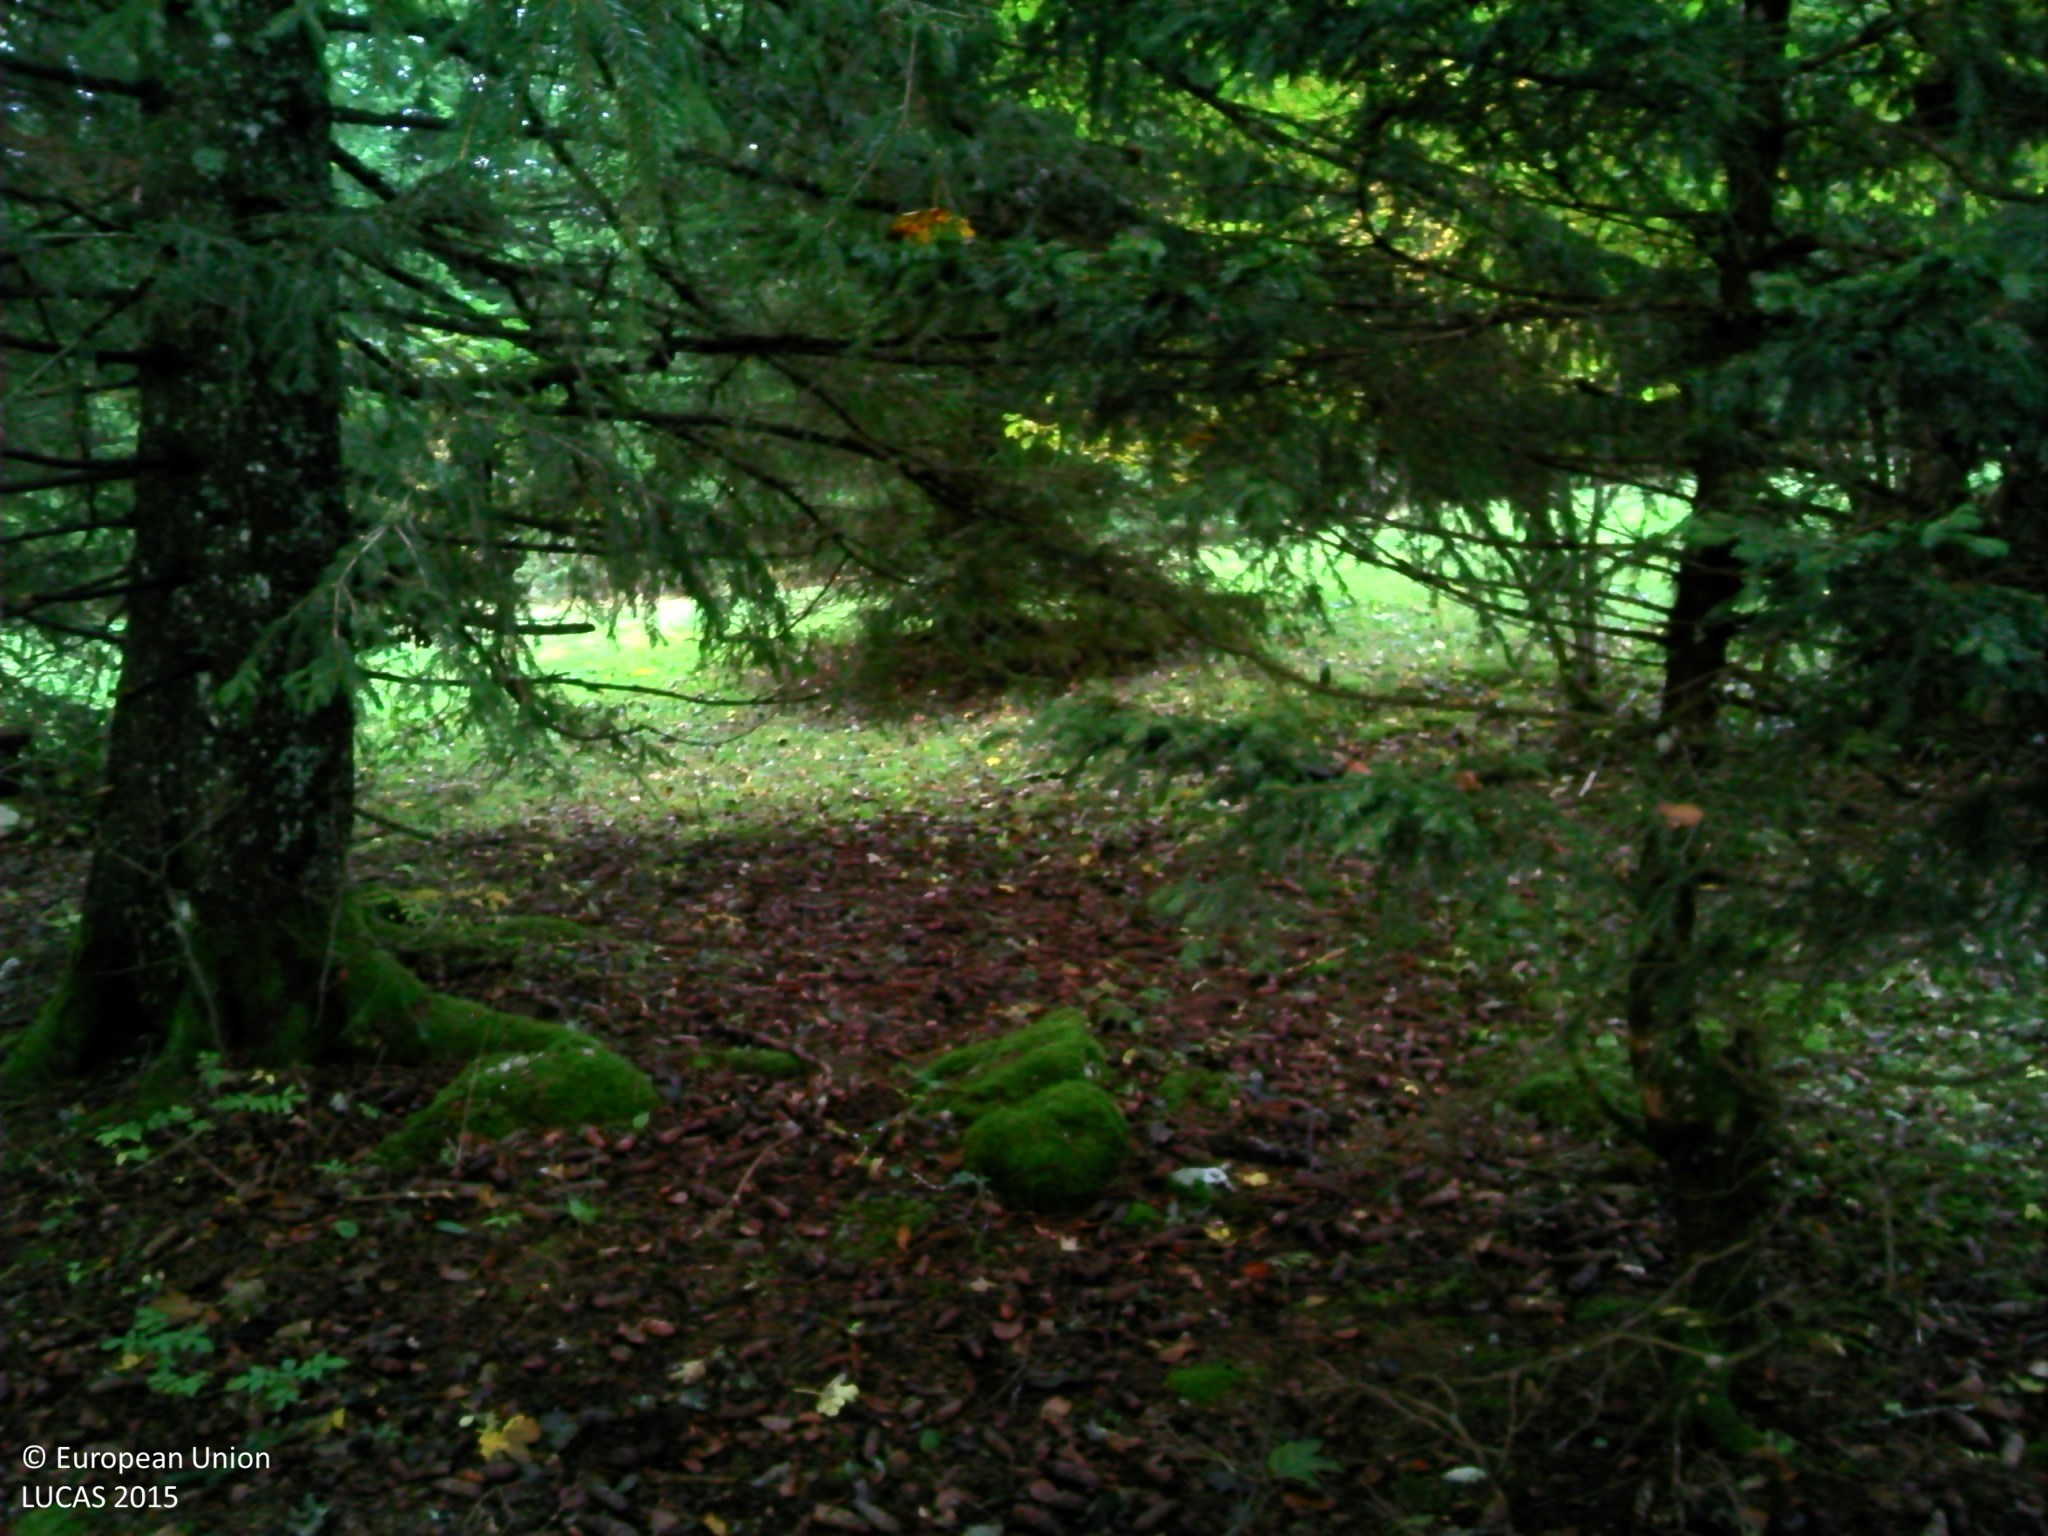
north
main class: Woodland
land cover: Spruce dominated mixed woodland
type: mountainous beech forest
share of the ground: > 75 %
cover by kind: coniferous forest trees 60 %, broadleaved forest trees 40 %
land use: Agriculture (excluding fallow land and kitchen gardens)
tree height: > 5 m
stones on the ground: < 10 %
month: October
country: FR
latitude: 46.7388
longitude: 6.3250
